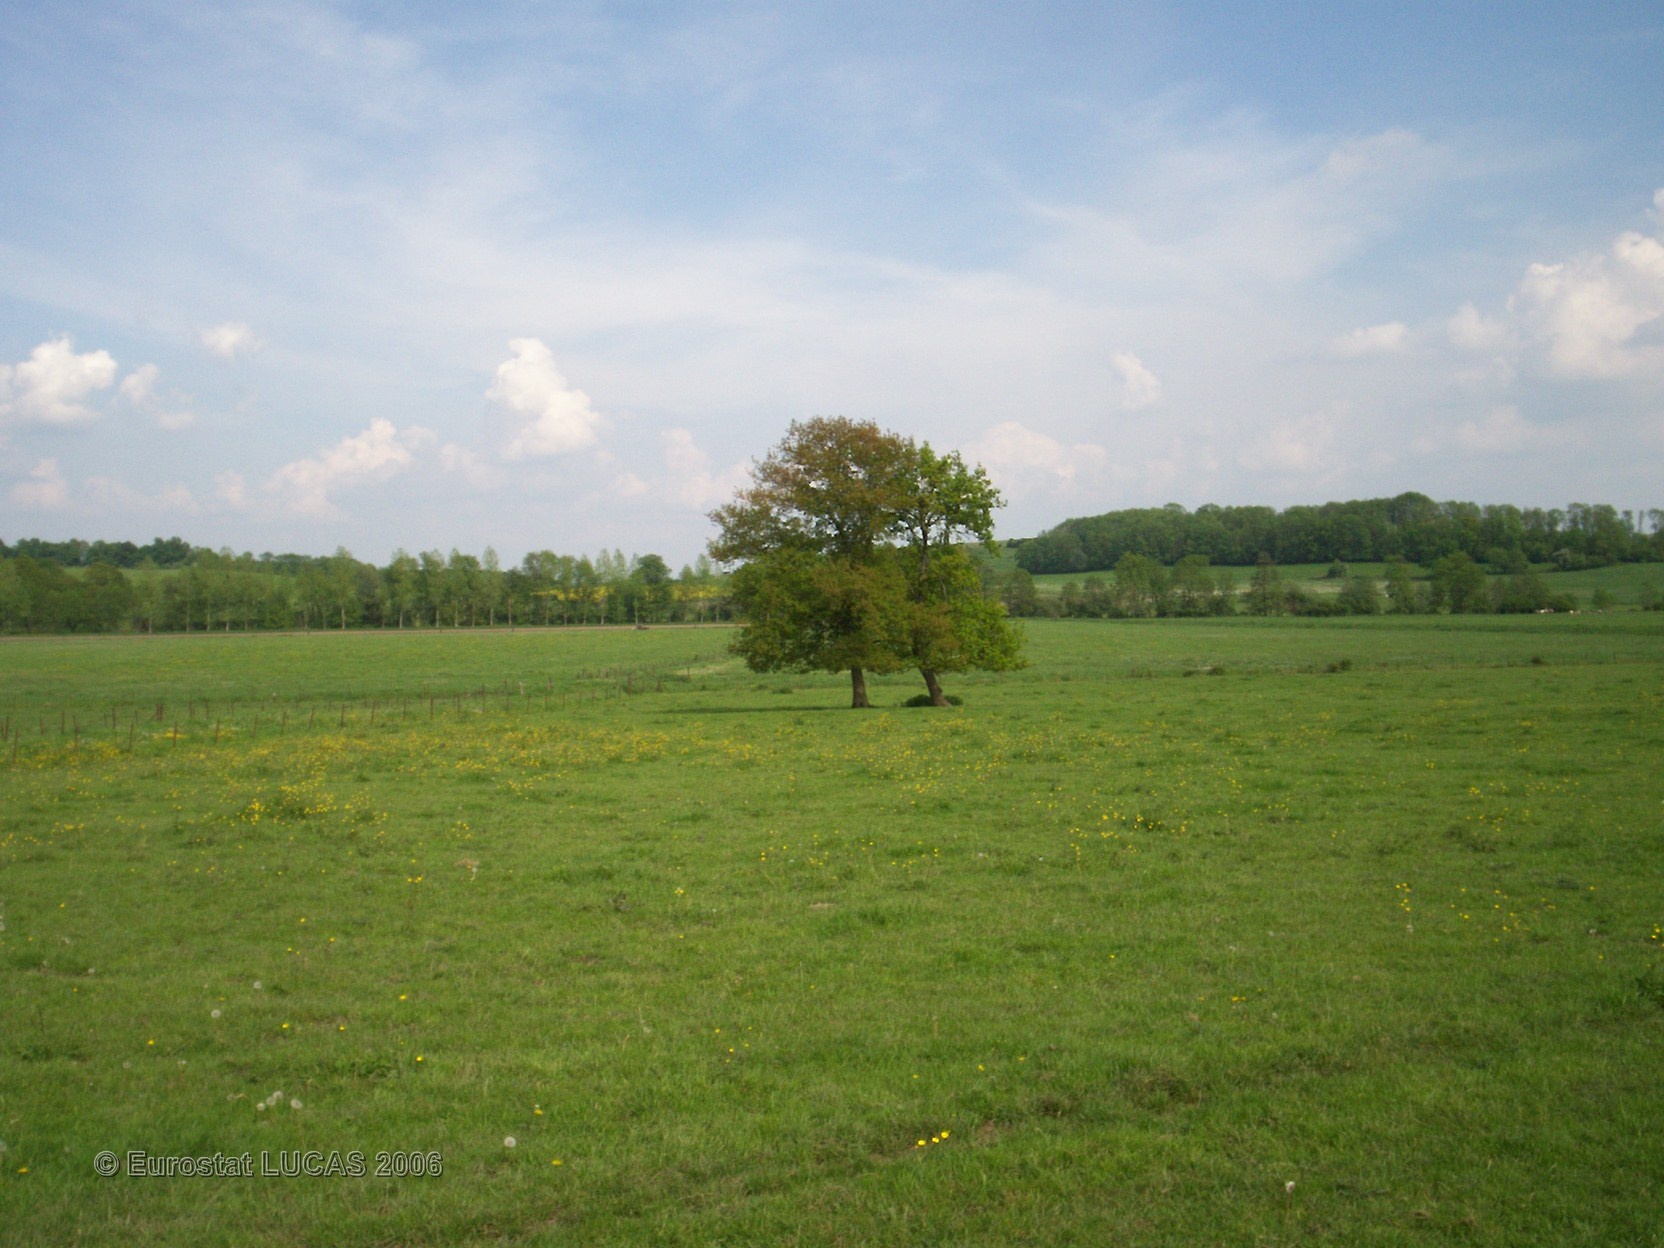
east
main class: Grassland
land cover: Grassland without tree/shrub cover
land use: Agriculture (excluding fallow land and kitchen gardens)
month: May
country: FR
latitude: 49.6273
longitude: 4.3057
